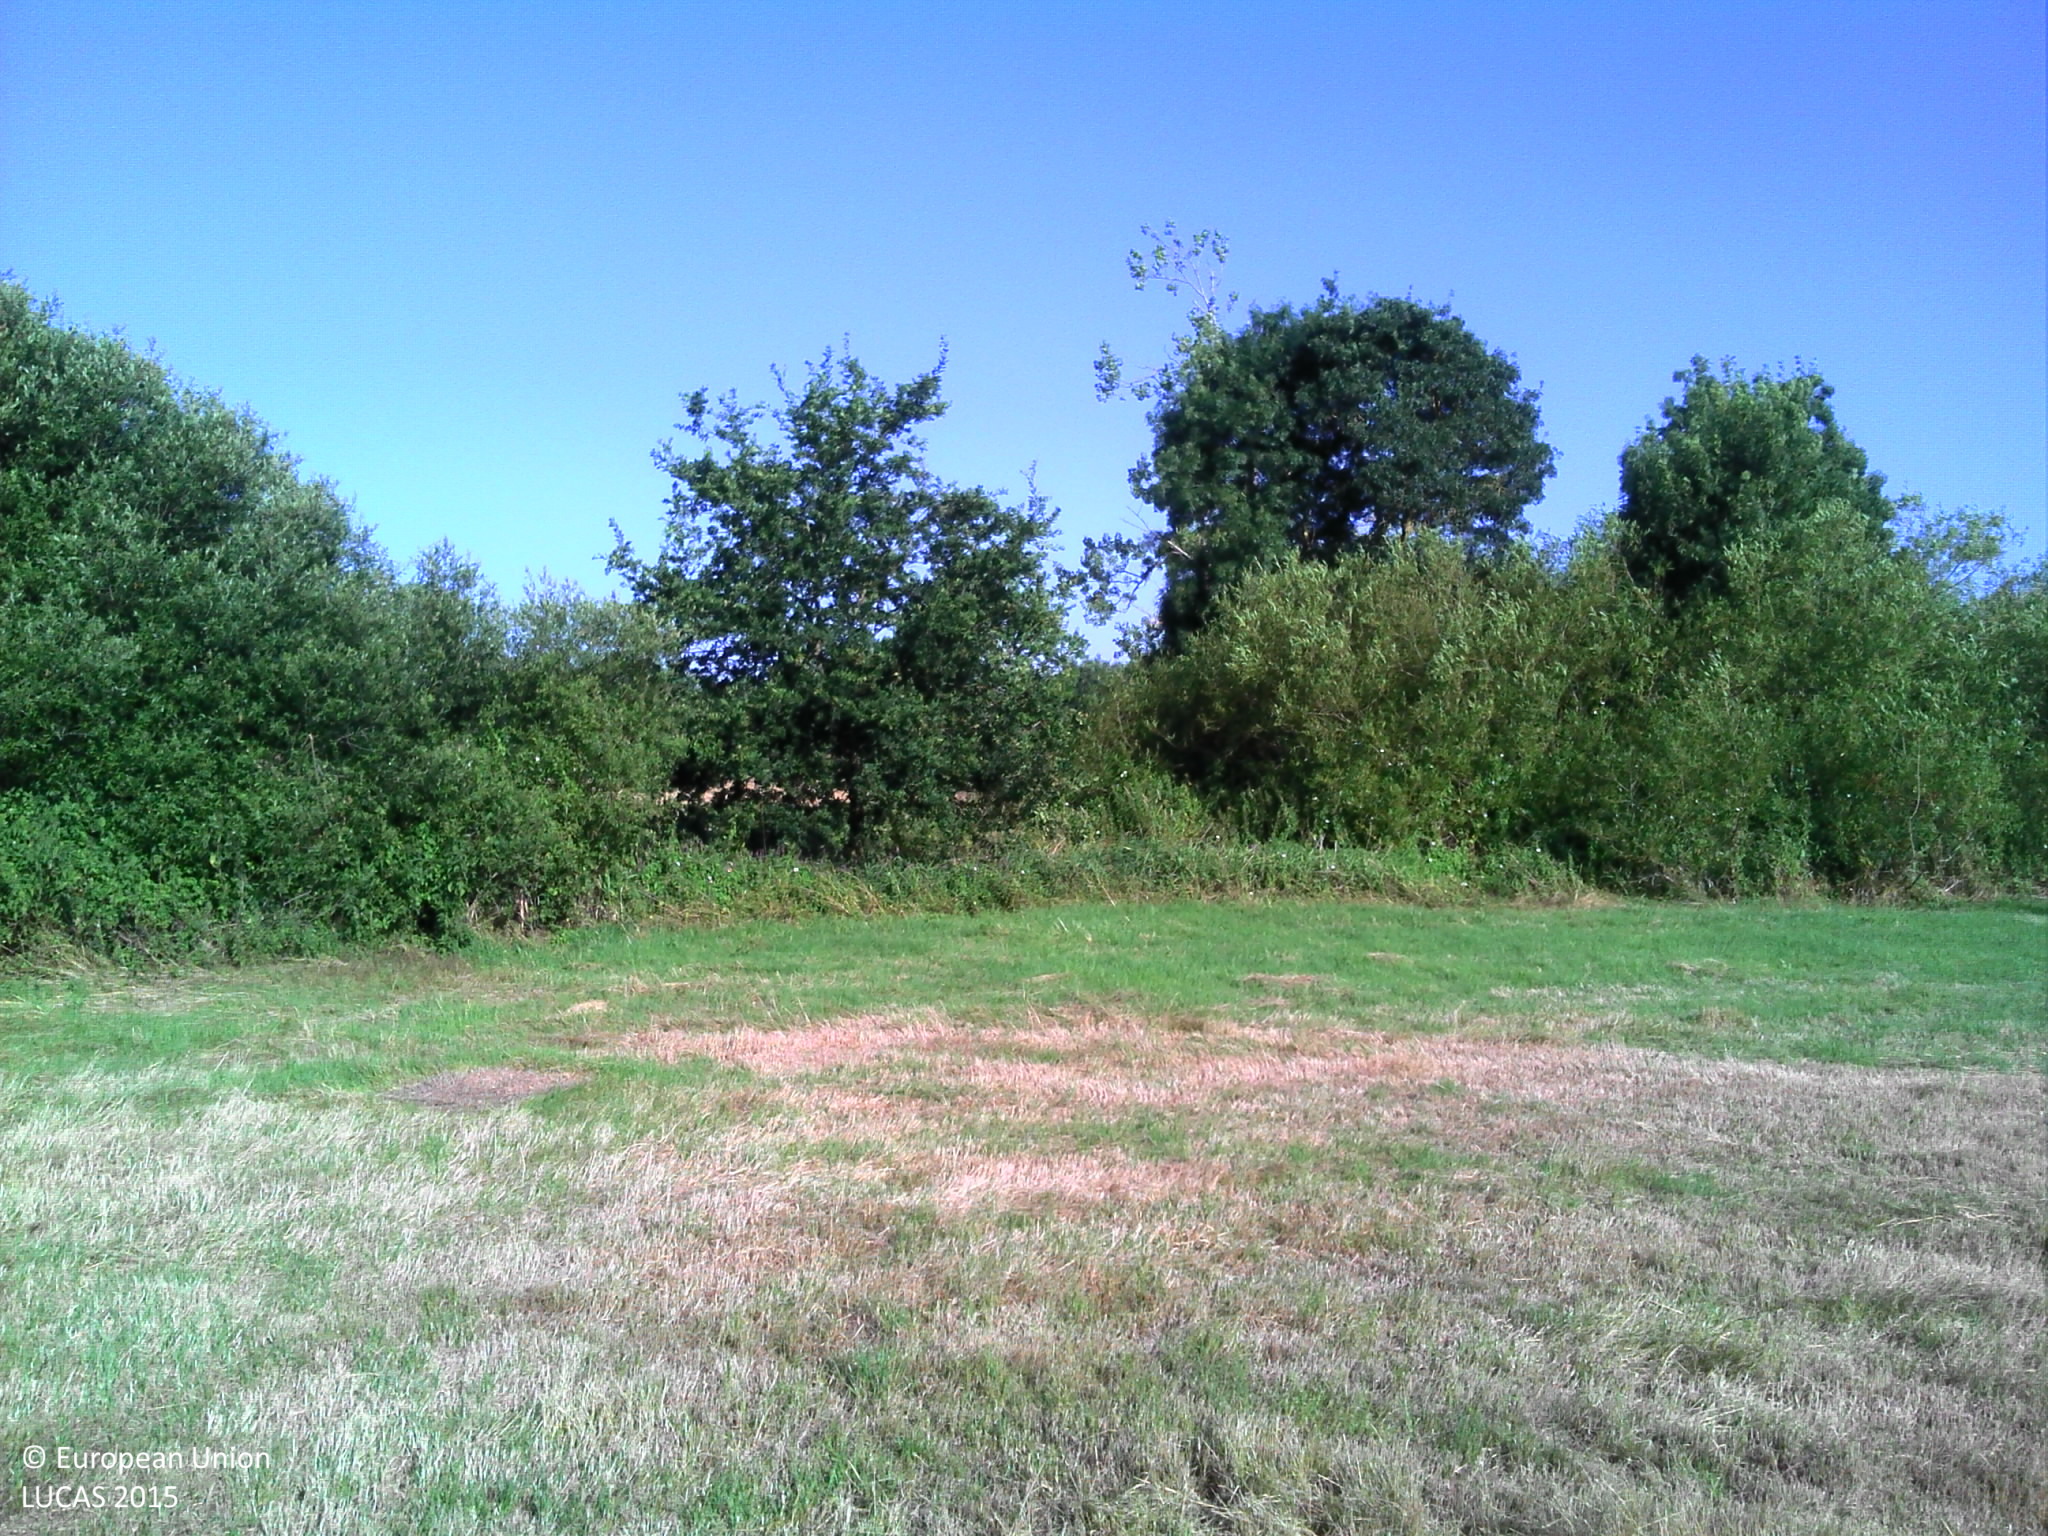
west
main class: Cropland
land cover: Temporary grasslands
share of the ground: > 75 %
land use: Agriculture (excluding fallow land and kitchen gardens)
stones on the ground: < 10 %
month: July
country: FR
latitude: 47.6776
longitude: -1.9715
